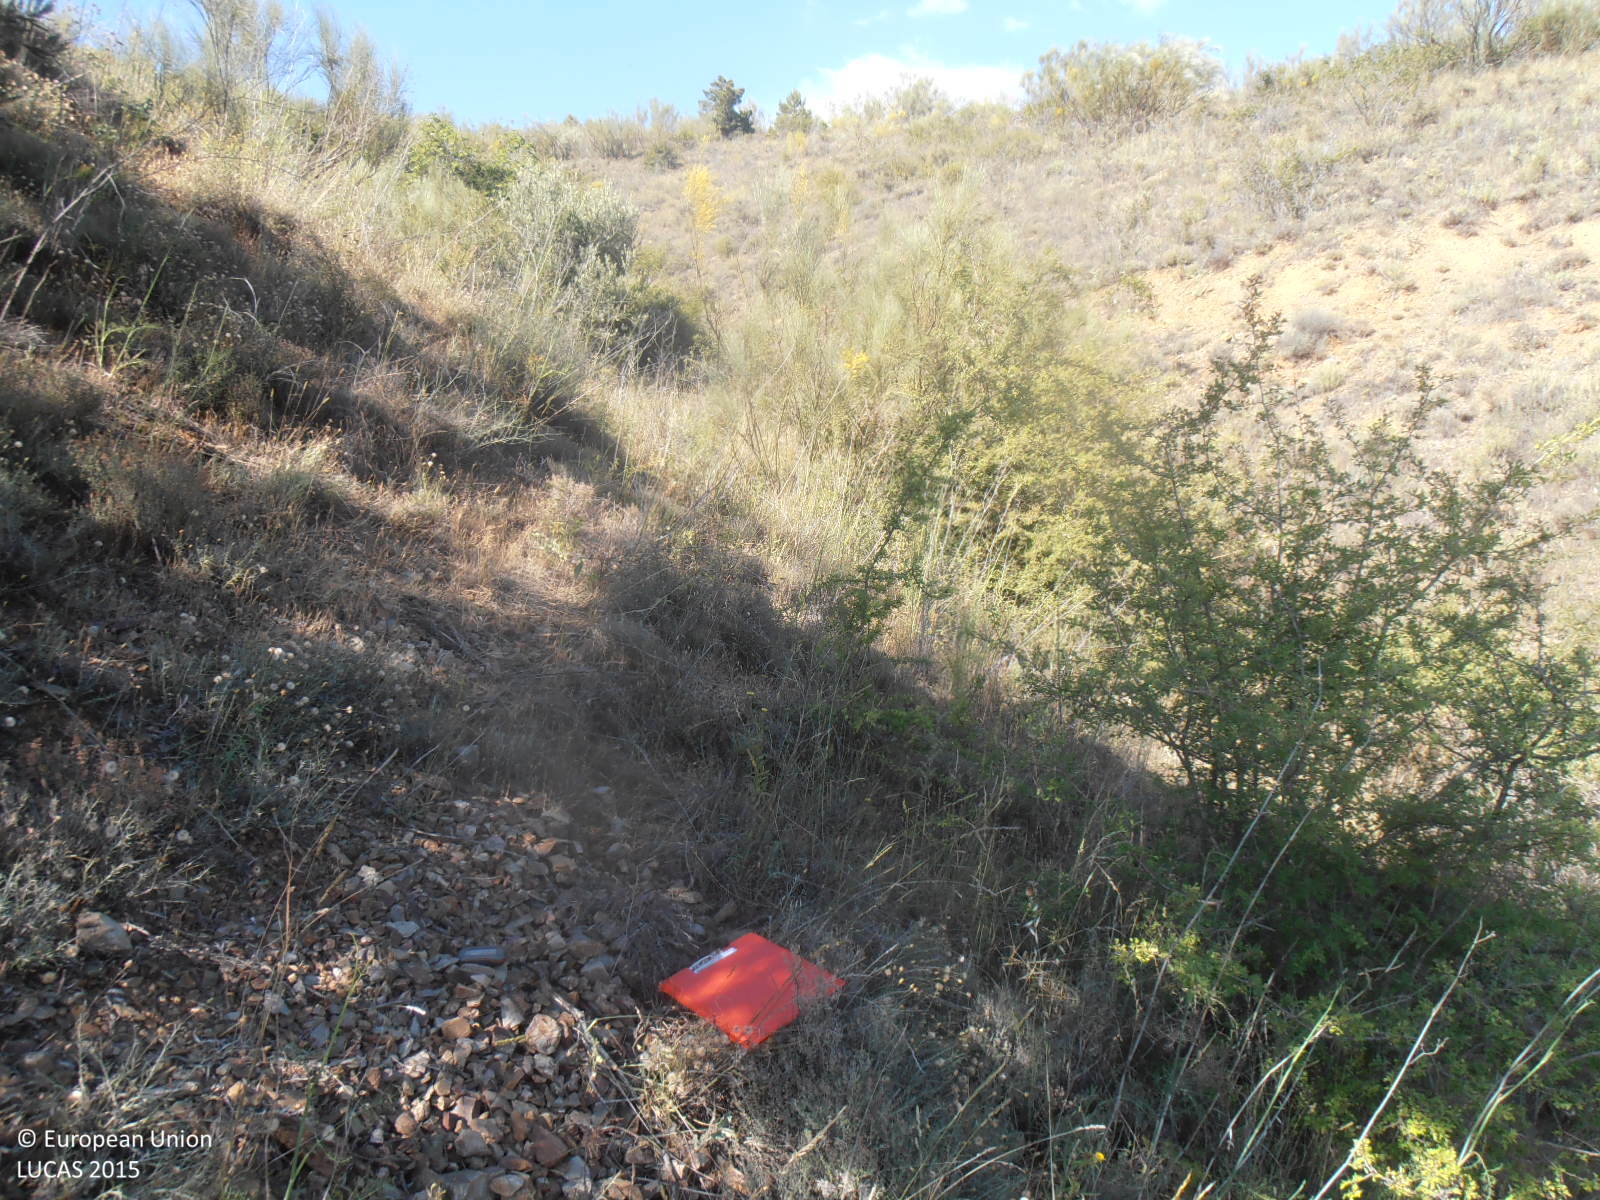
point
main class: Shrubland
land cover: Shrubland without tree cover
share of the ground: > 75 %
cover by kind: shrubs 100 %
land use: Abandoned areas
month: June
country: ES
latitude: 41.3532
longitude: -1.3899
